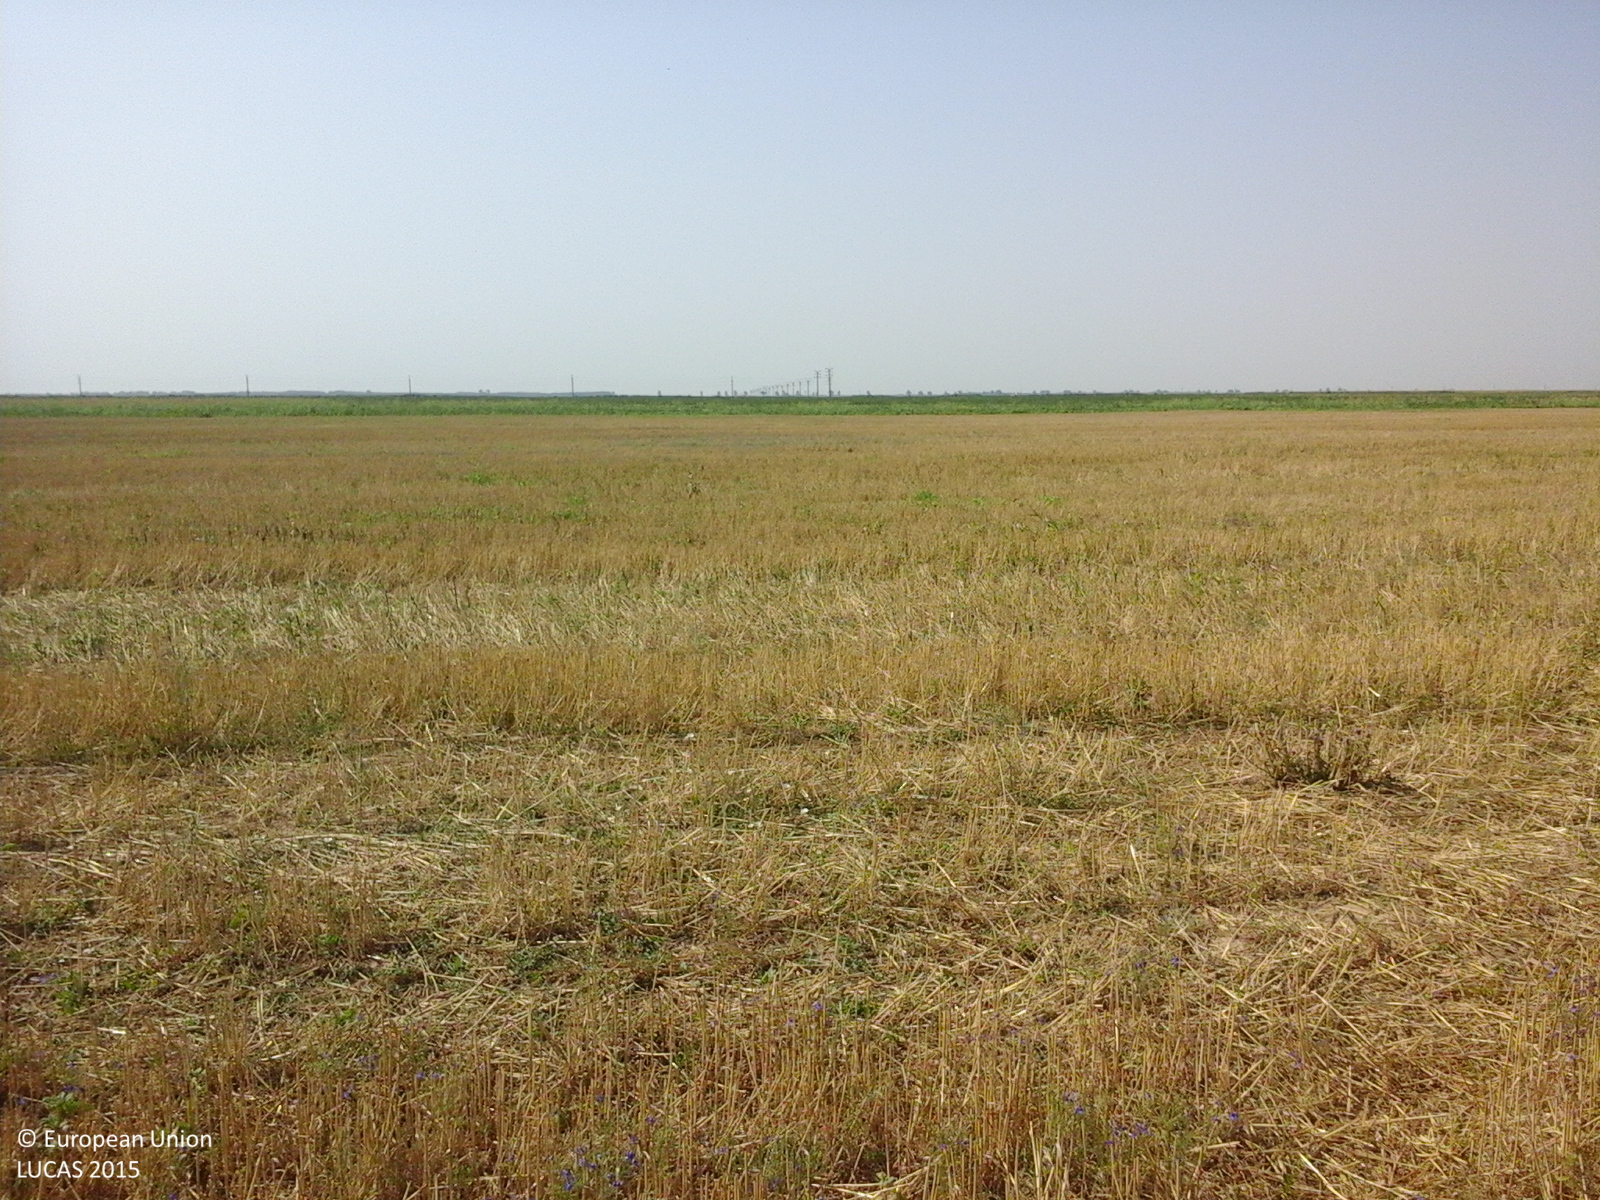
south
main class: Cropland
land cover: Common wheat
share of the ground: > 75 %
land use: Agriculture (excluding fallow land and kitchen gardens)
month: August
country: RO
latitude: 45.3767
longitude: 27.5856
